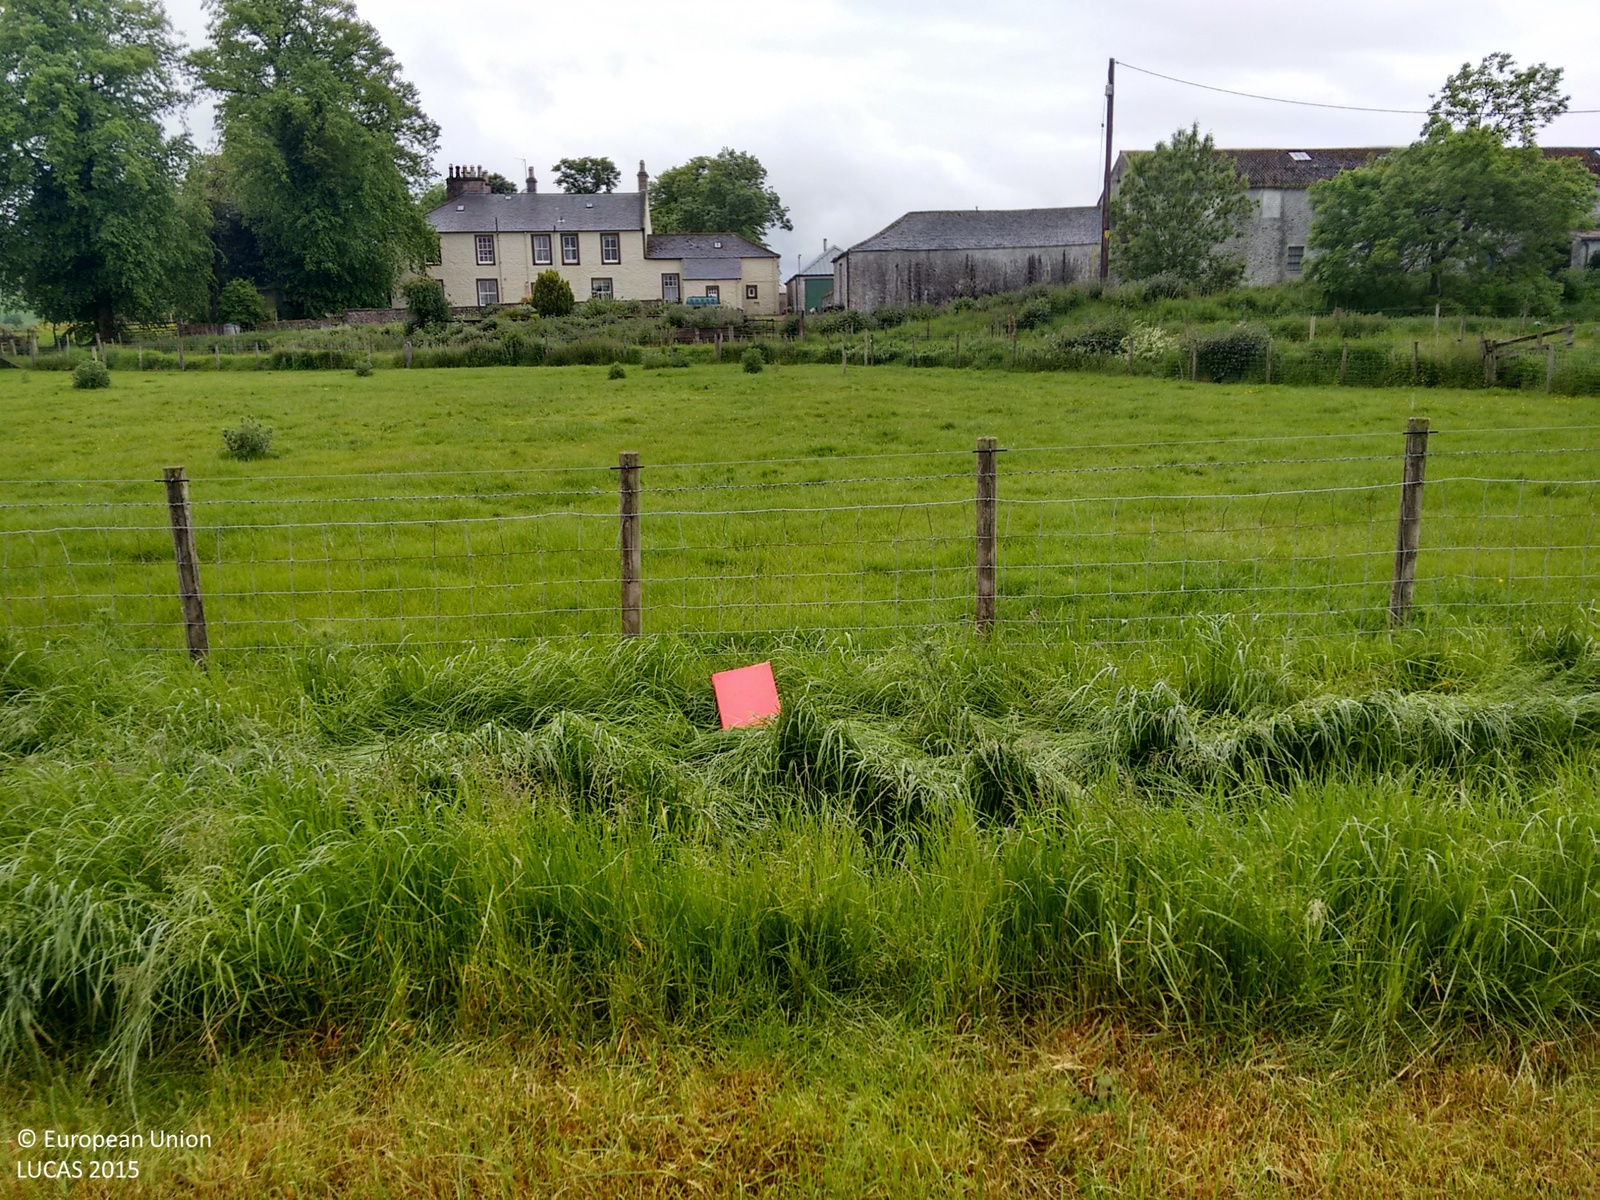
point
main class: Grassland
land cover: Grassland without tree/shrub cover
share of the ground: > 75 %
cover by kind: herbaceous plants 90 %, unconsolidated bare surface 10 %
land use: Agriculture (excluding fallow land and kitchen gardens)
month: June
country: GB
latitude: 55.1596
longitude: -3.4997
